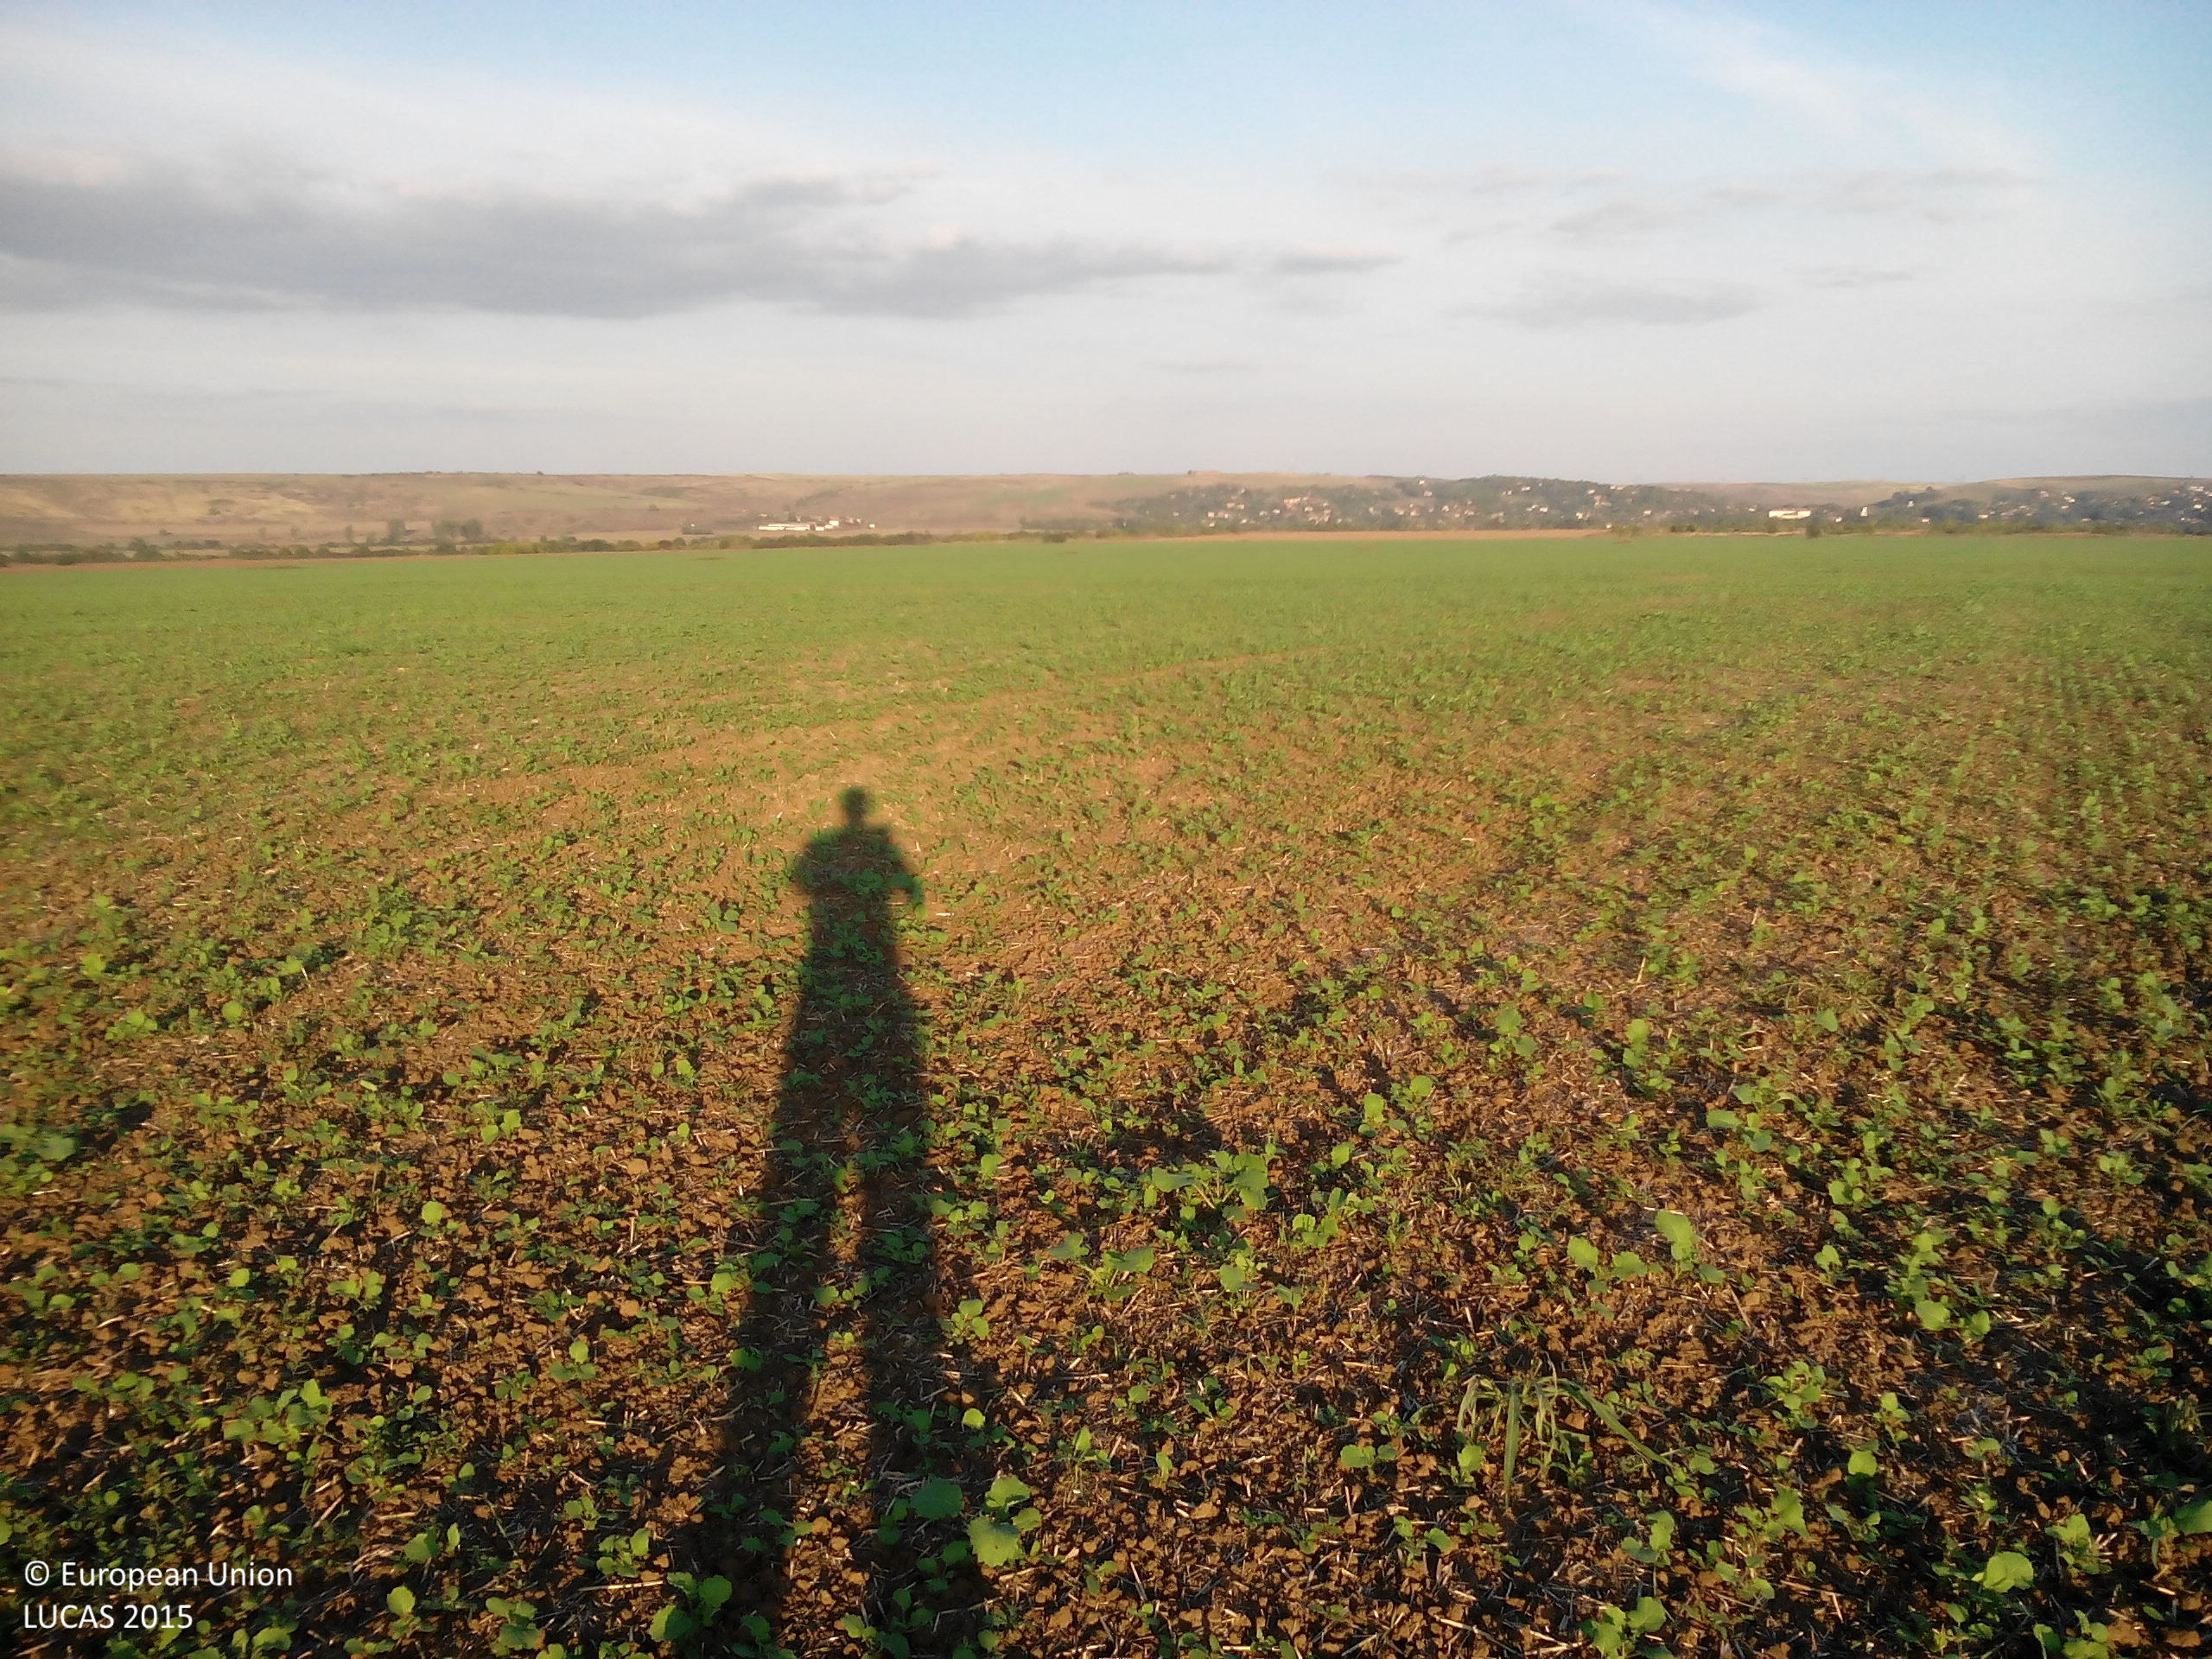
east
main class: Cropland
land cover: Common wheat
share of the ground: < 10 %
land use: Agriculture (excluding fallow land and kitchen gardens)
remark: Harvested field
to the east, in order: Common wheat
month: October
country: BG
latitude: 43.5655
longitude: 23.8305
